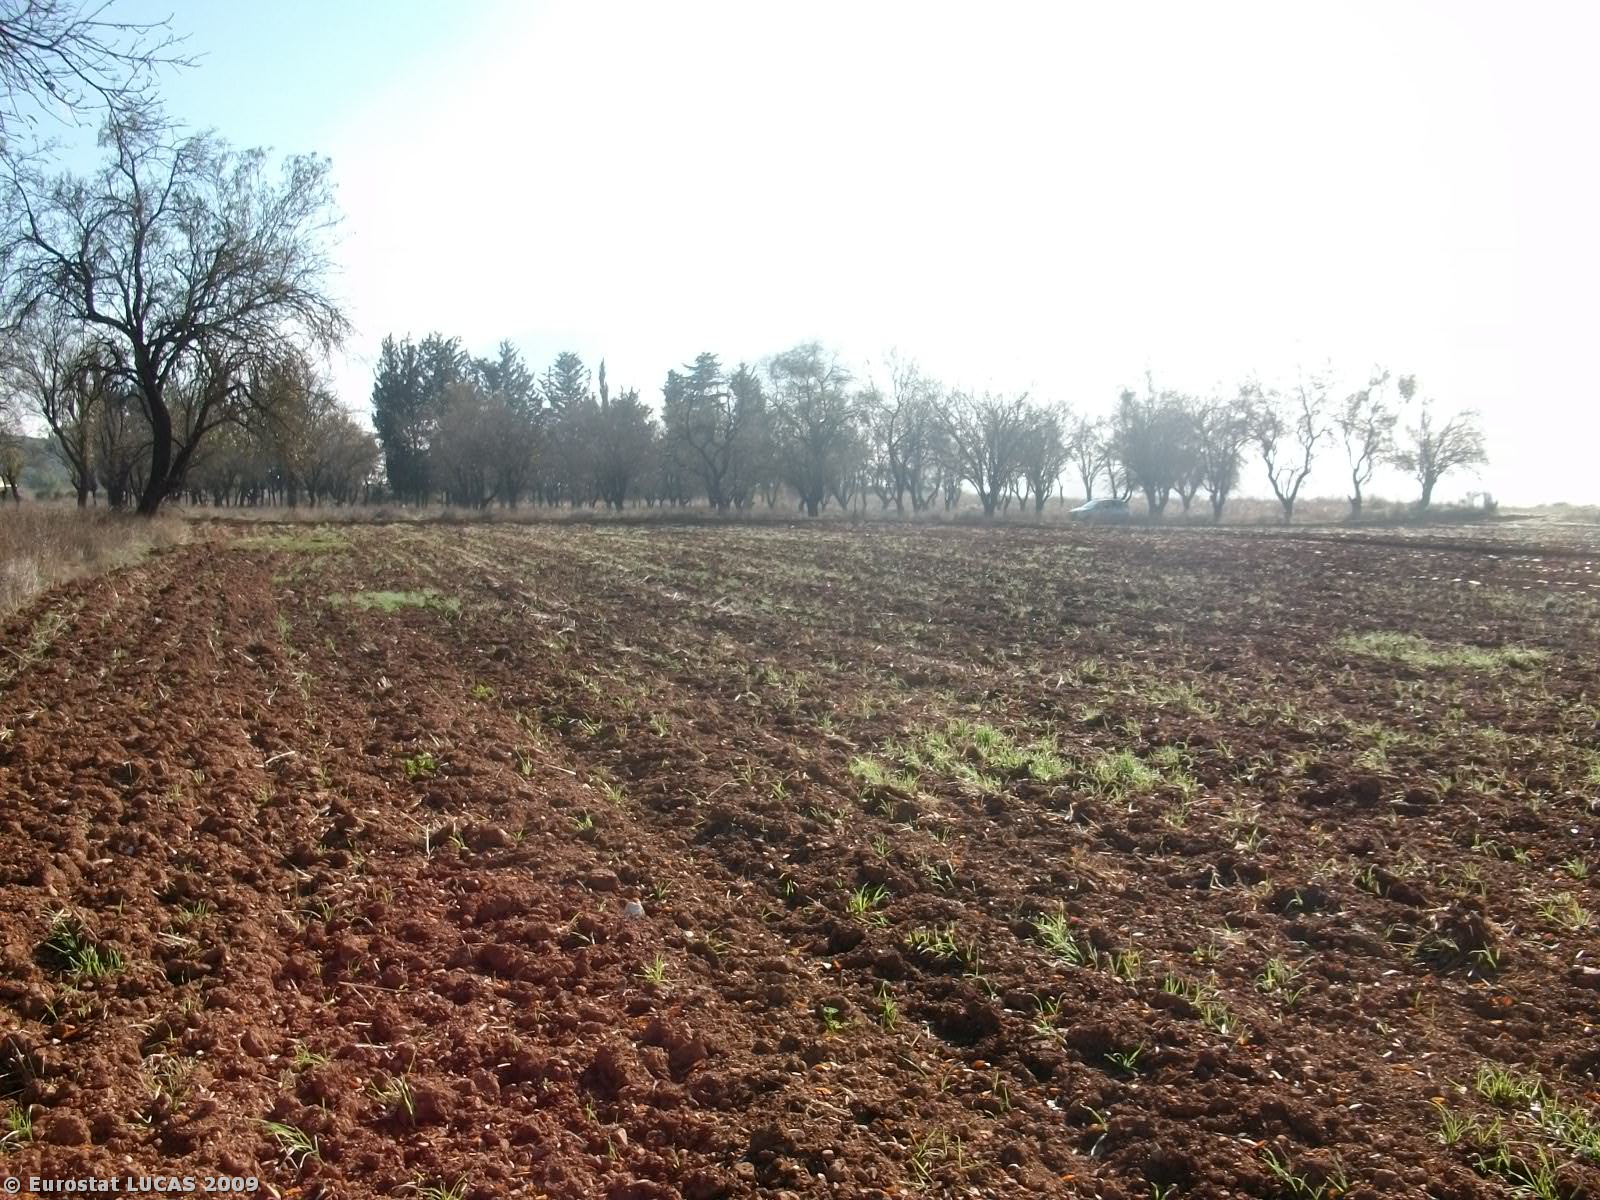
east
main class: Bare land
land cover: Bare land
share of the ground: > 75 %
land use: Fallow land
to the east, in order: Bare land; Fences; Broadleaved woodland; Tracks; Broadleaved woodland; Grassland without tree/shrub cover; Coniferous woodland; Shrubland with sparse tree cover; Tracks; Shrubland without tree cover; Ditches and canals; Shrubland without tree cover; Grassland without tree/shrub cover
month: October
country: GR
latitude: 38.0367
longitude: 22.0784
